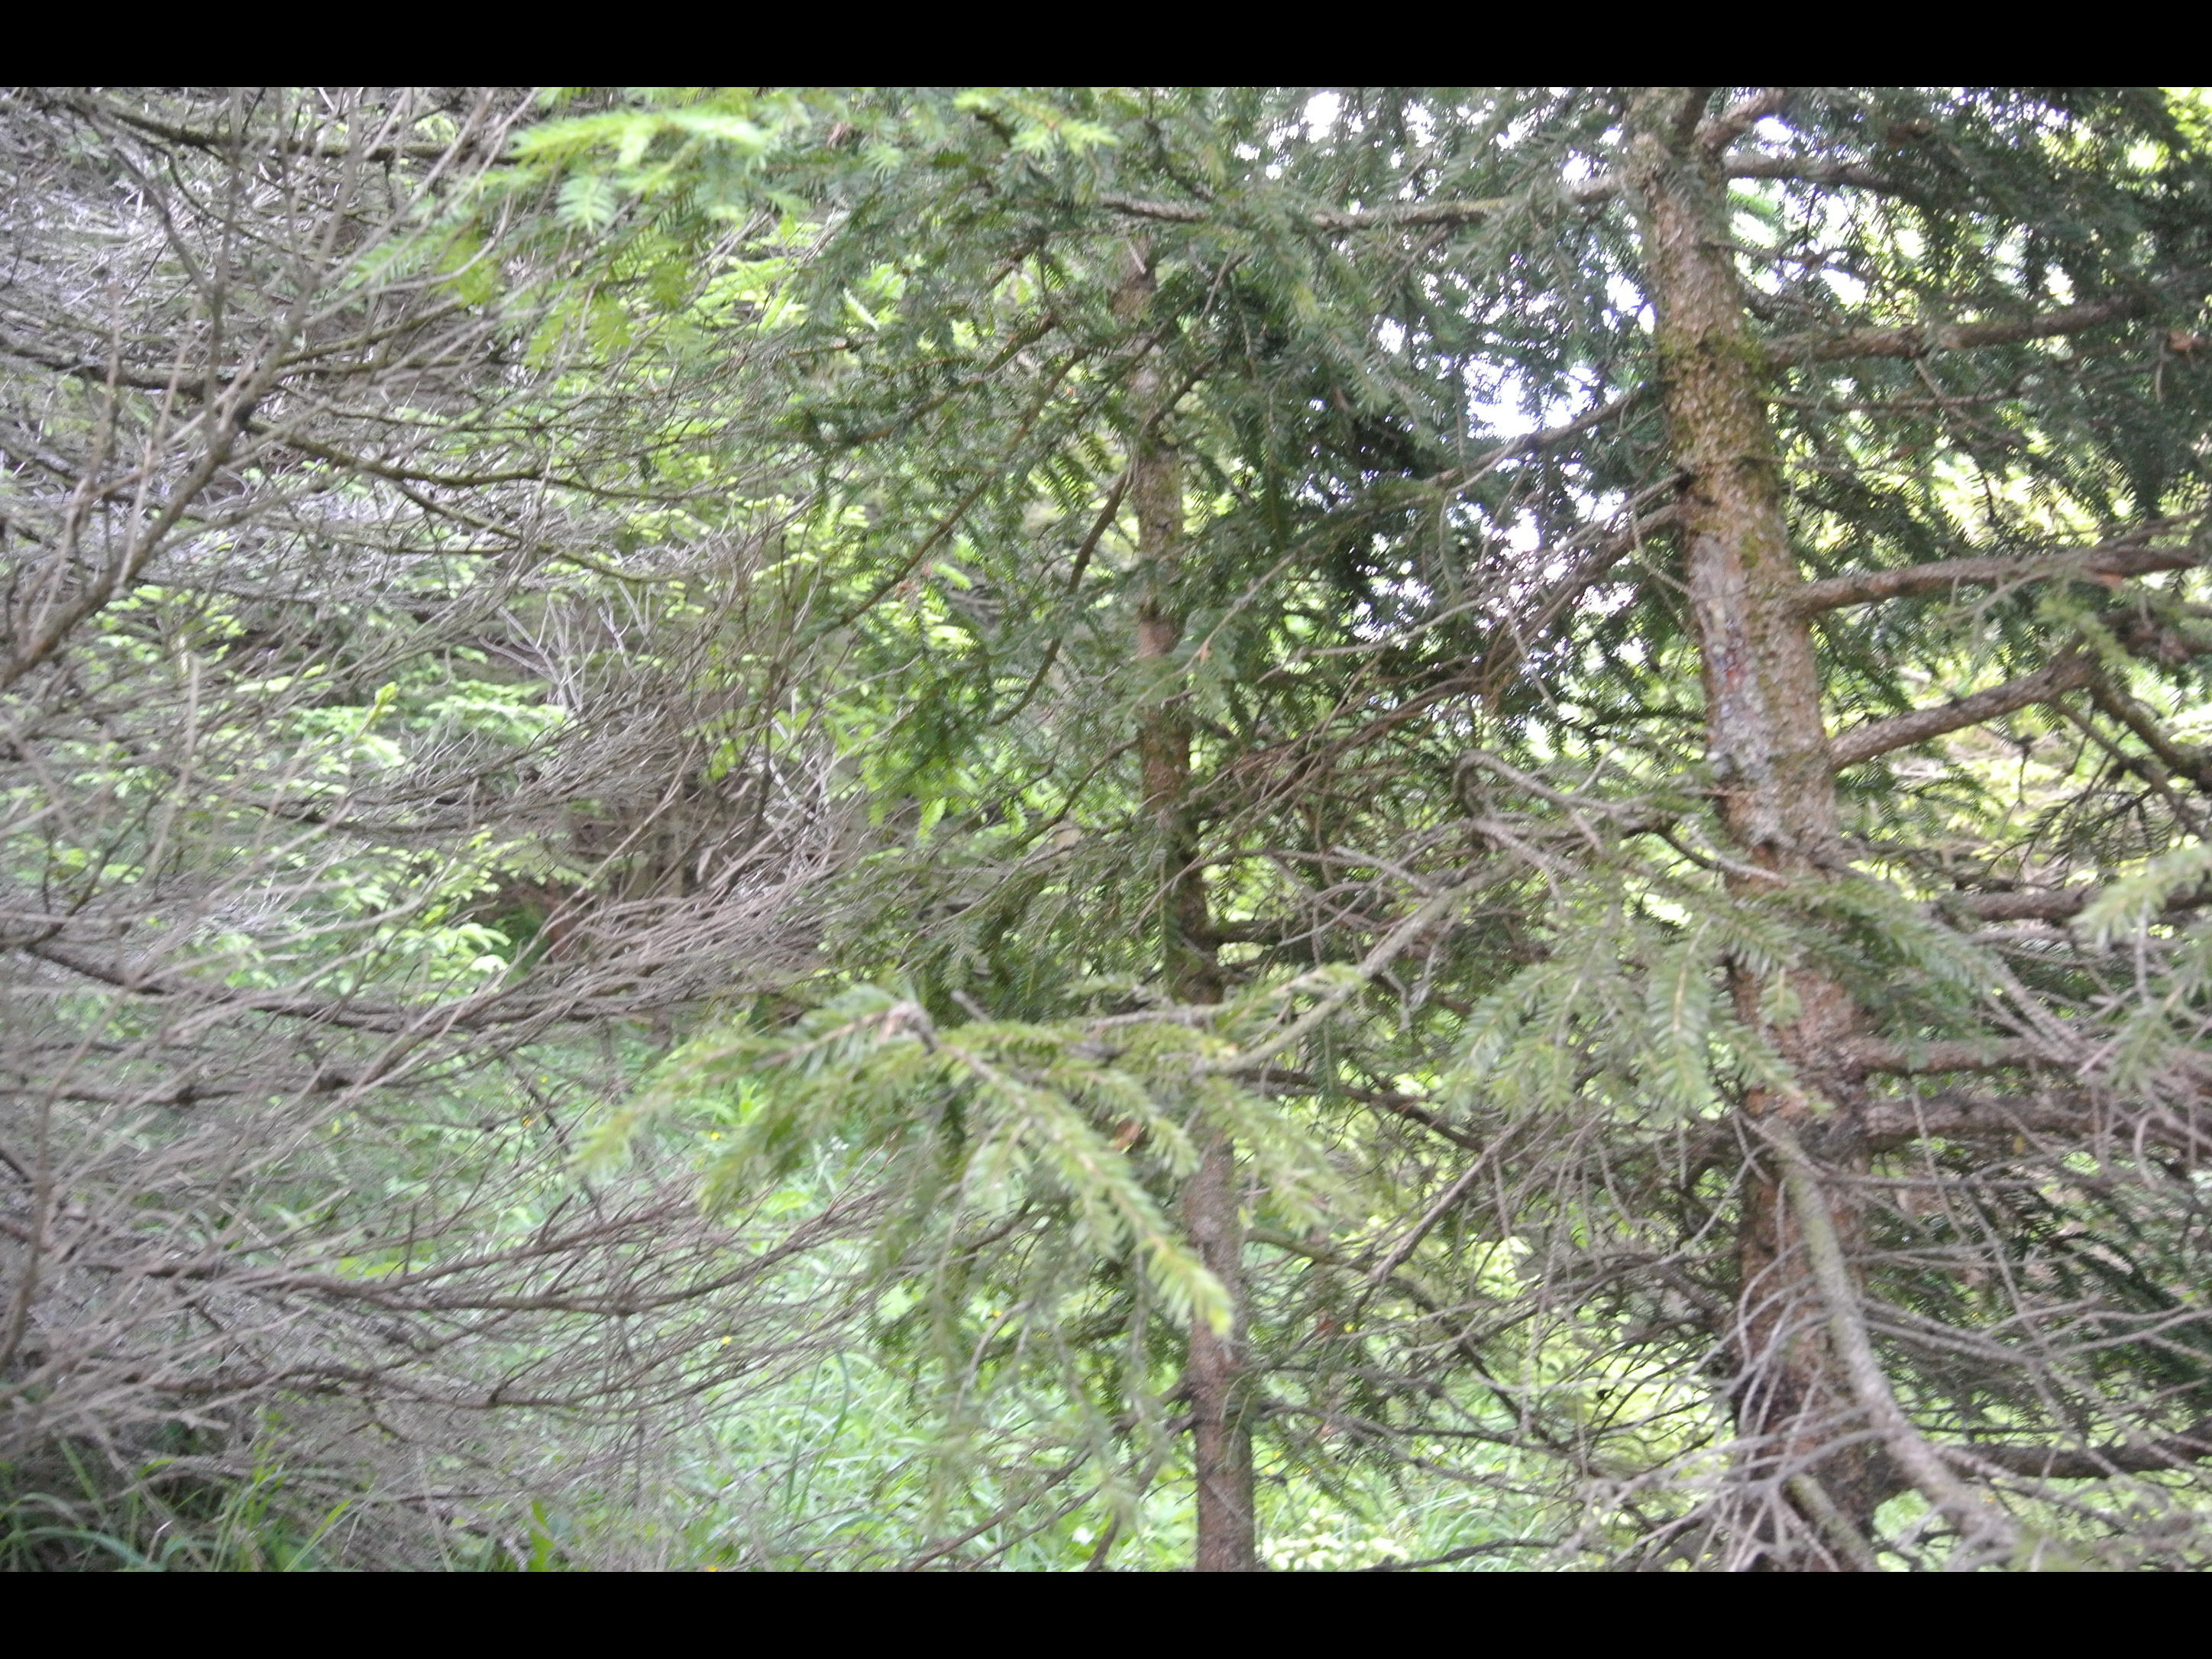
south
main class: Woodland
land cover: Spruce dominated coniferous woodland
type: alpine coniferous forest
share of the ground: > 75 %
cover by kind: coniferous forest trees 90 %, herbaceous plants 10 %
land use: Forestry
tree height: > 5 m
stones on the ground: > 50 %
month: June
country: AT
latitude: 47.8574
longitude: 15.3879
